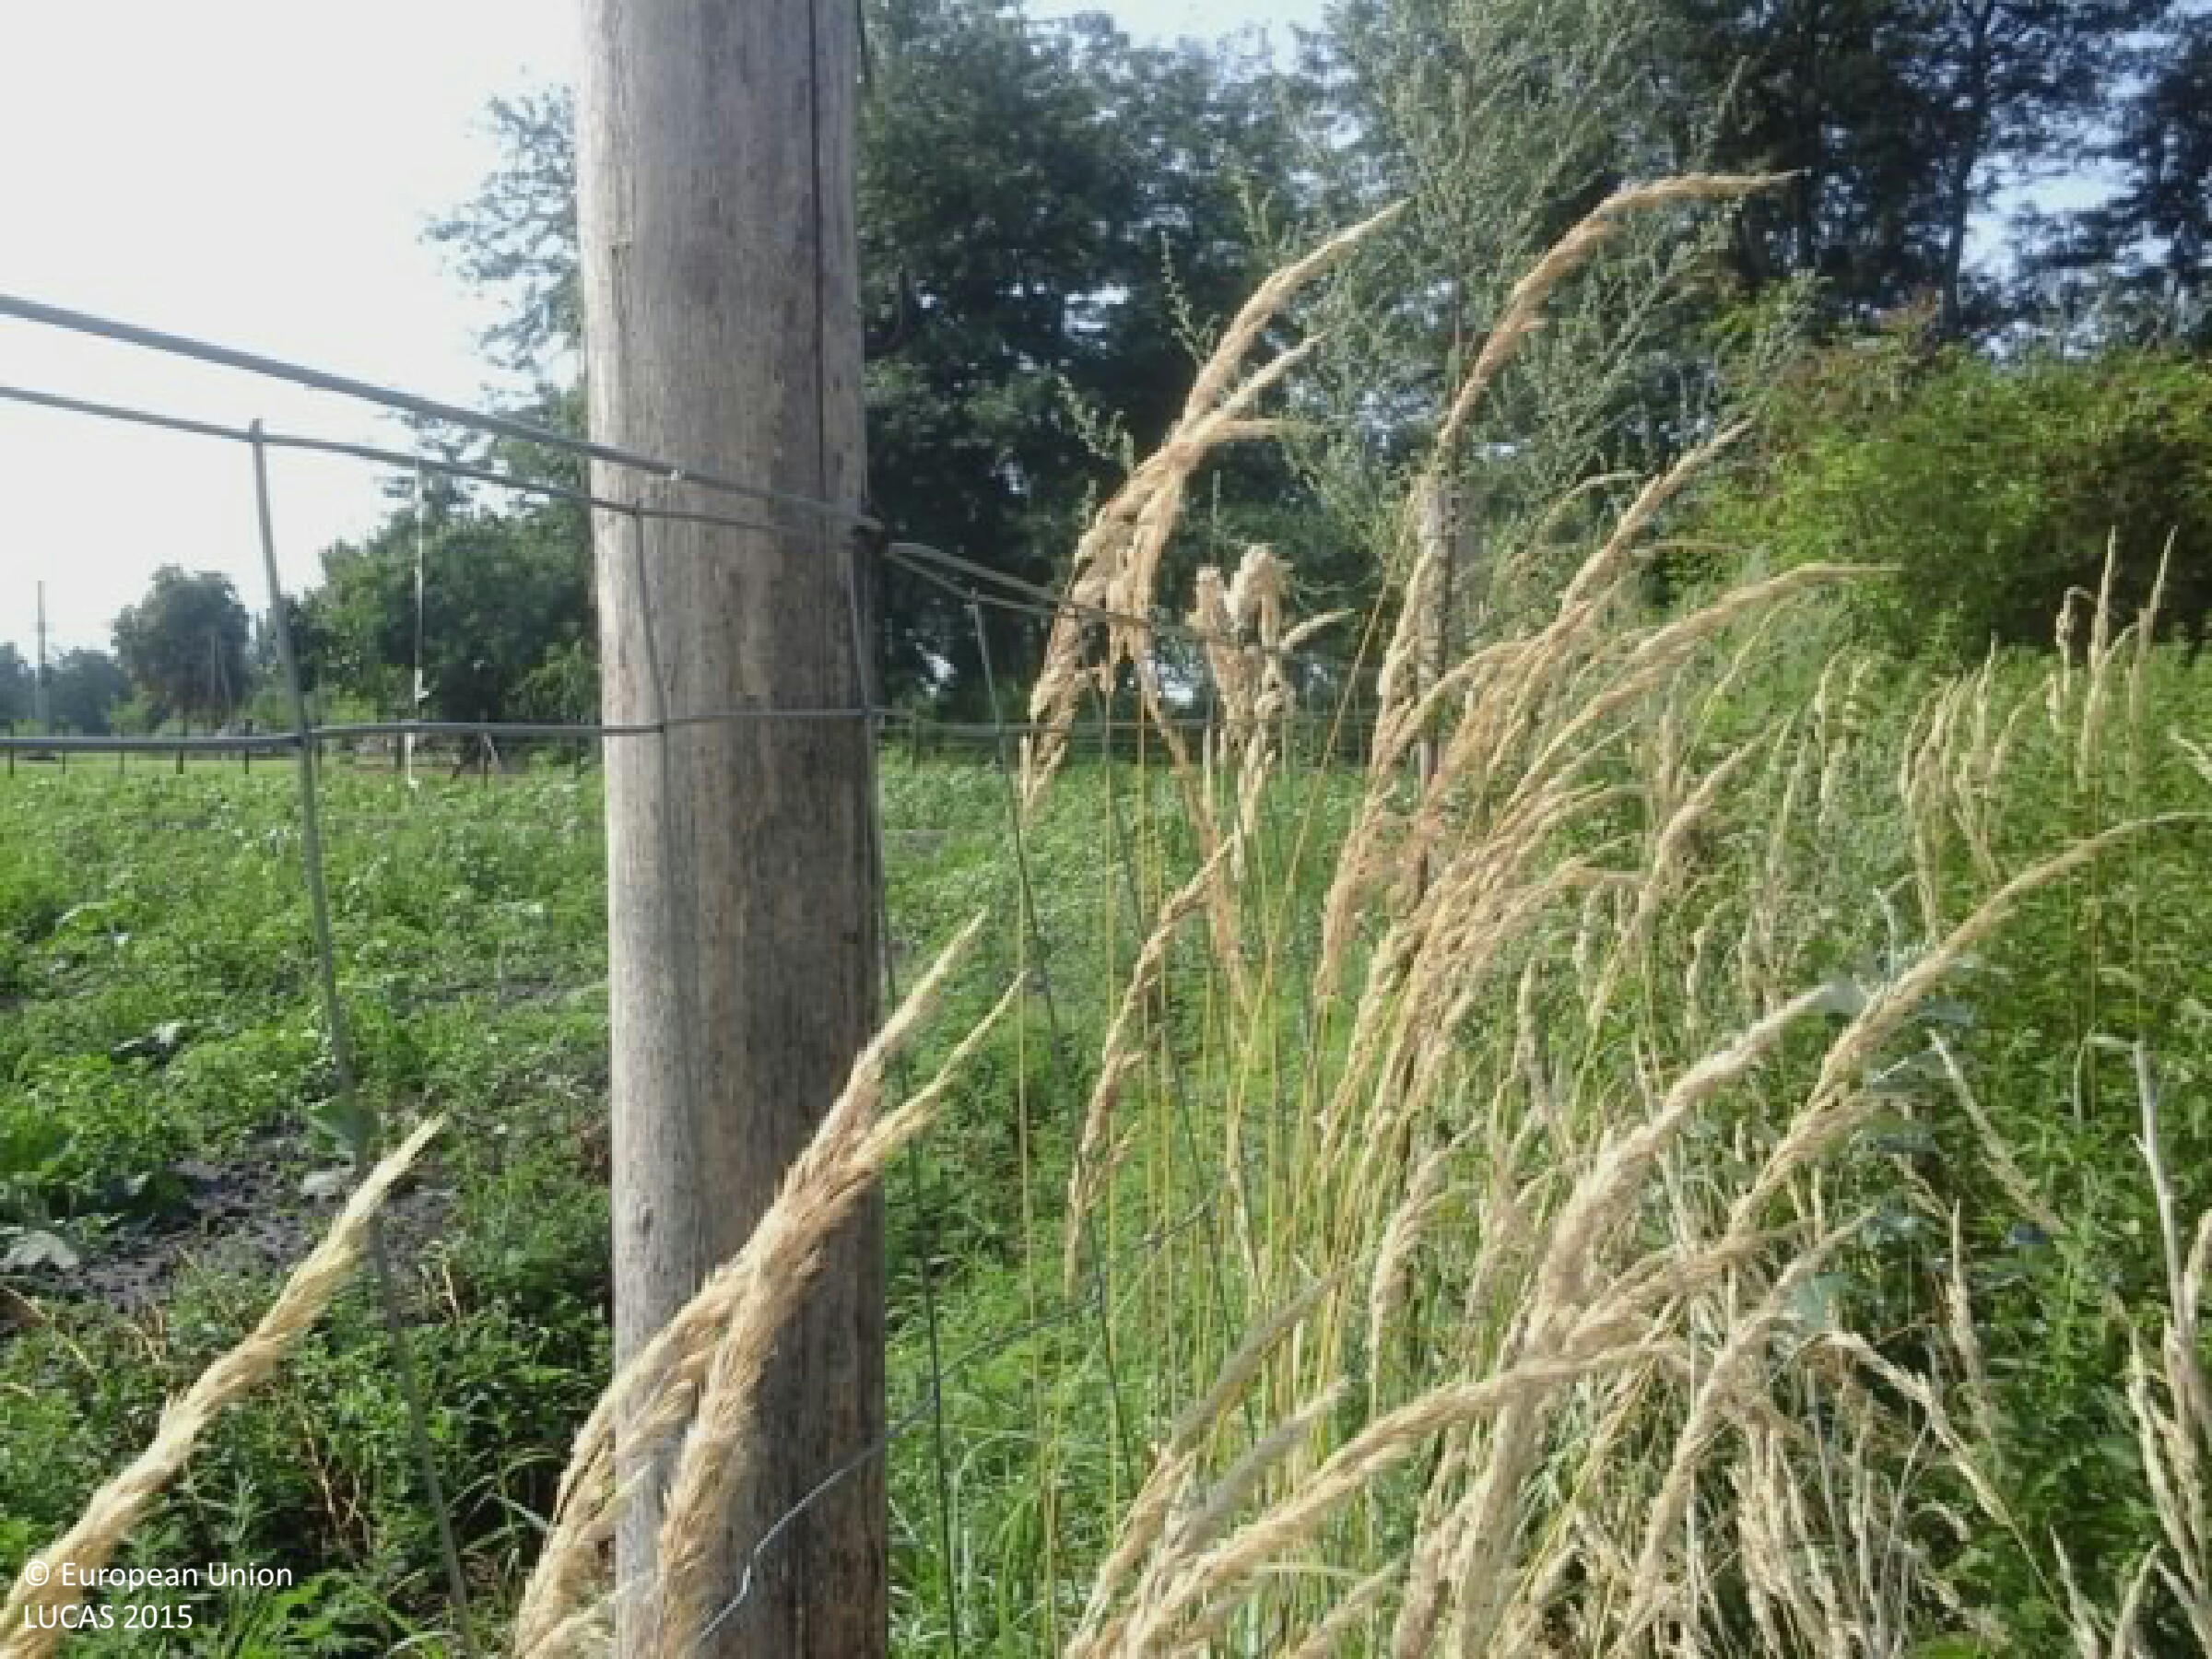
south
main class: Grassland
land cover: Spontaneously vegetated surfaces
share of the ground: > 75 %
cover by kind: herbaceous plants 100 %
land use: Fallow land
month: August
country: HU
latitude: 47.1744
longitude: 19.7463
